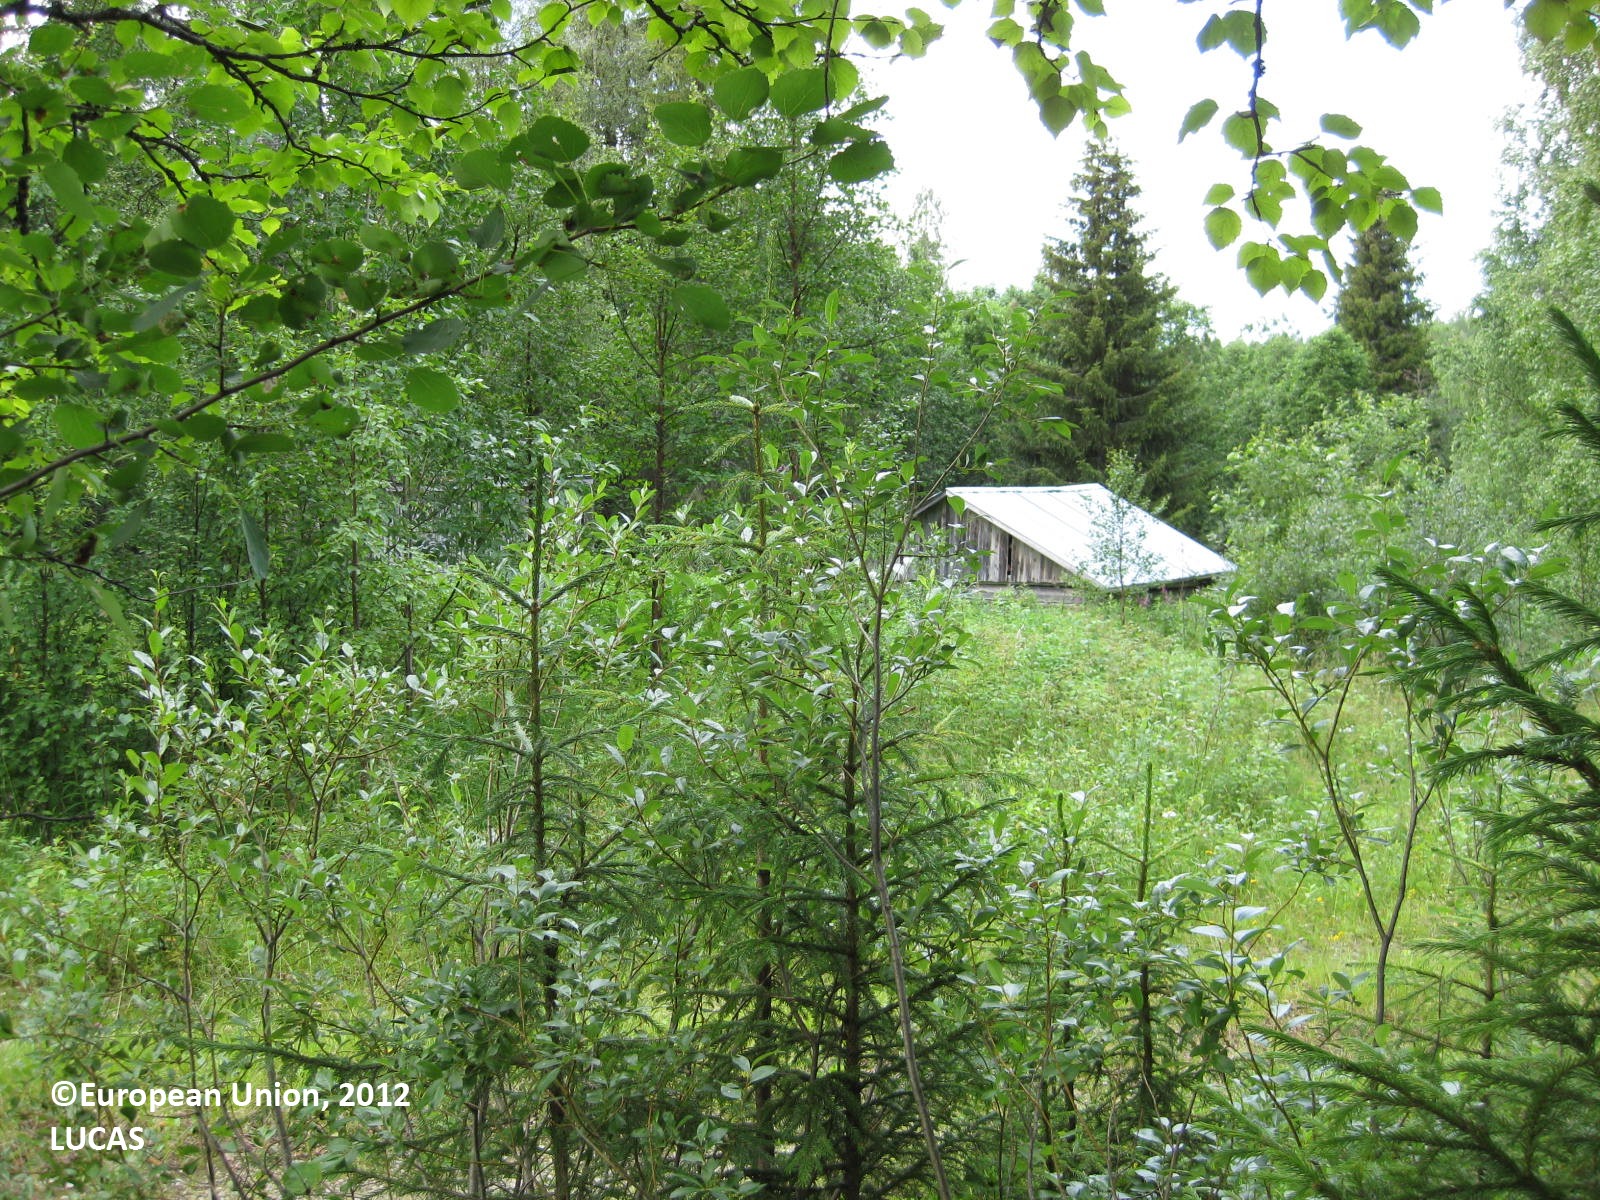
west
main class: Woodland
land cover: Spruce dominated mixed woodland
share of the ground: > 75 %
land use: Residential
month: July
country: FI
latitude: 65.7034
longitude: 28.5203
